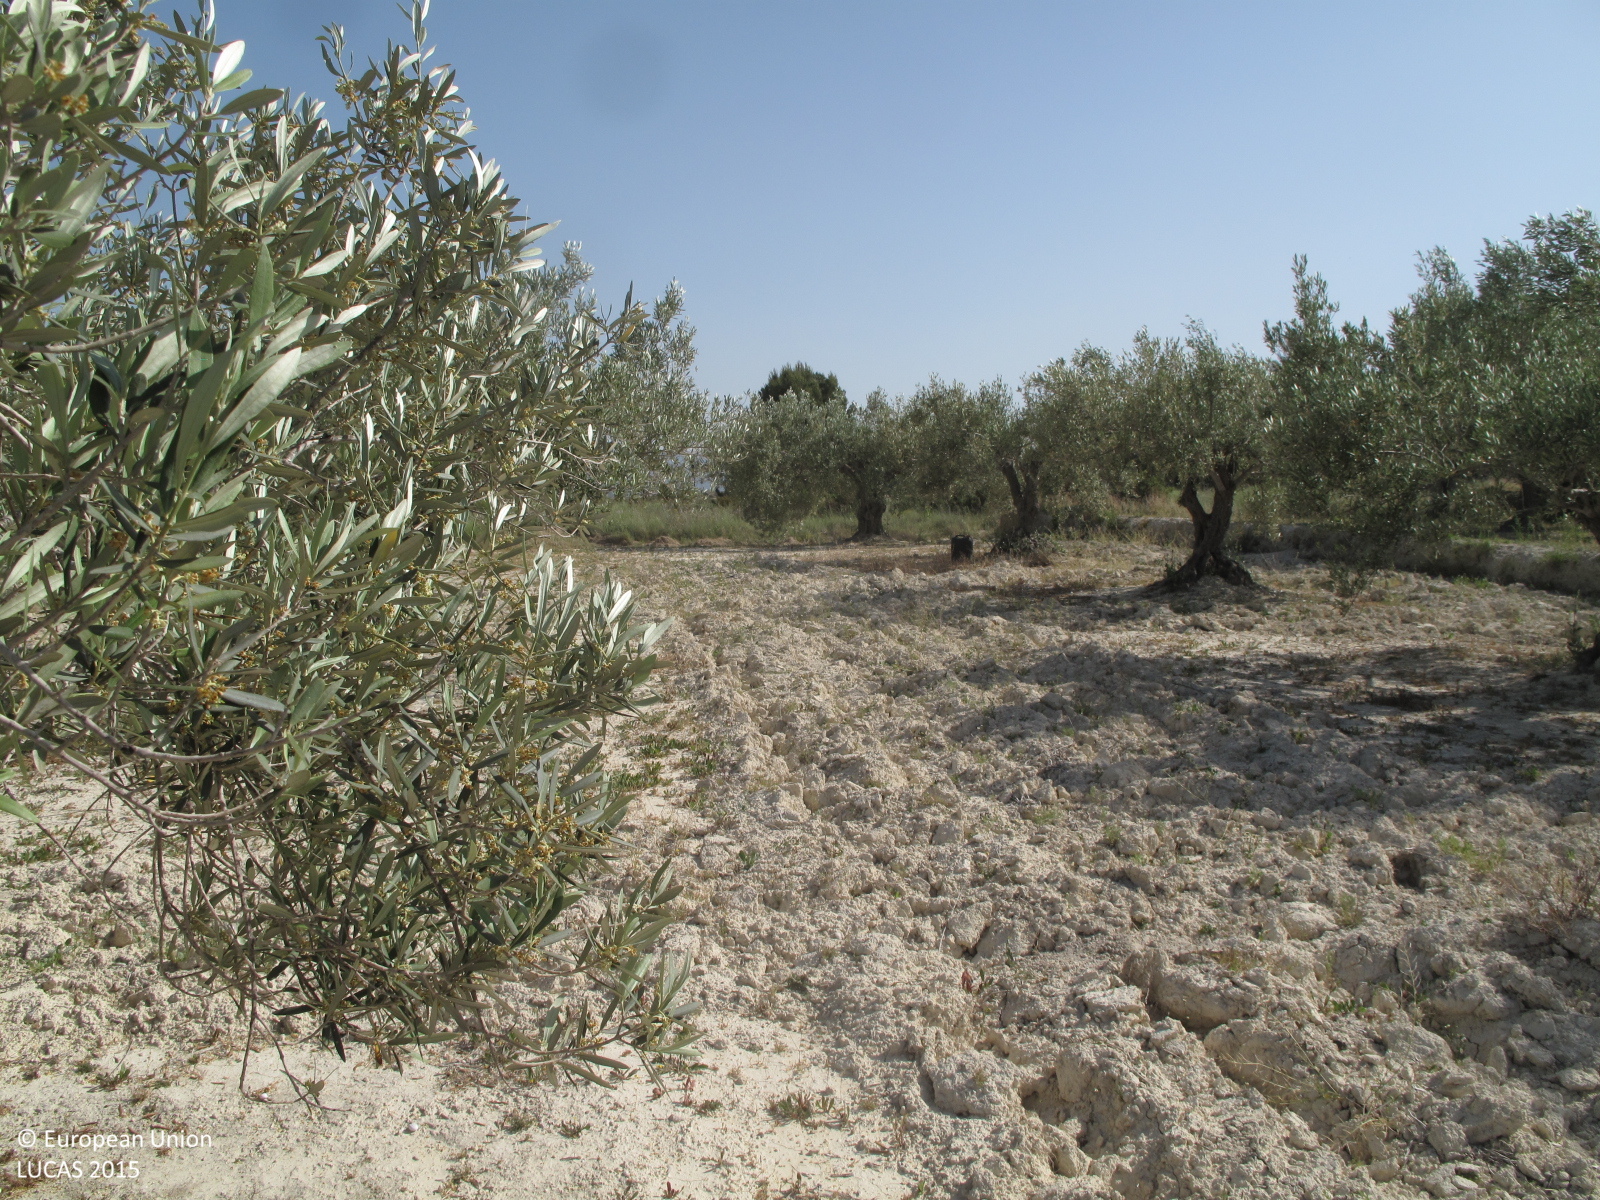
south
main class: Cropland
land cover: Olive groves
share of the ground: 25 - 50 %
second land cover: Spontaneously vegetated surfaces
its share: > 75 %
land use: Agriculture (excluding fallow land and kitchen gardens)
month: May
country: ES
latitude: 38.9106
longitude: -0.5671
